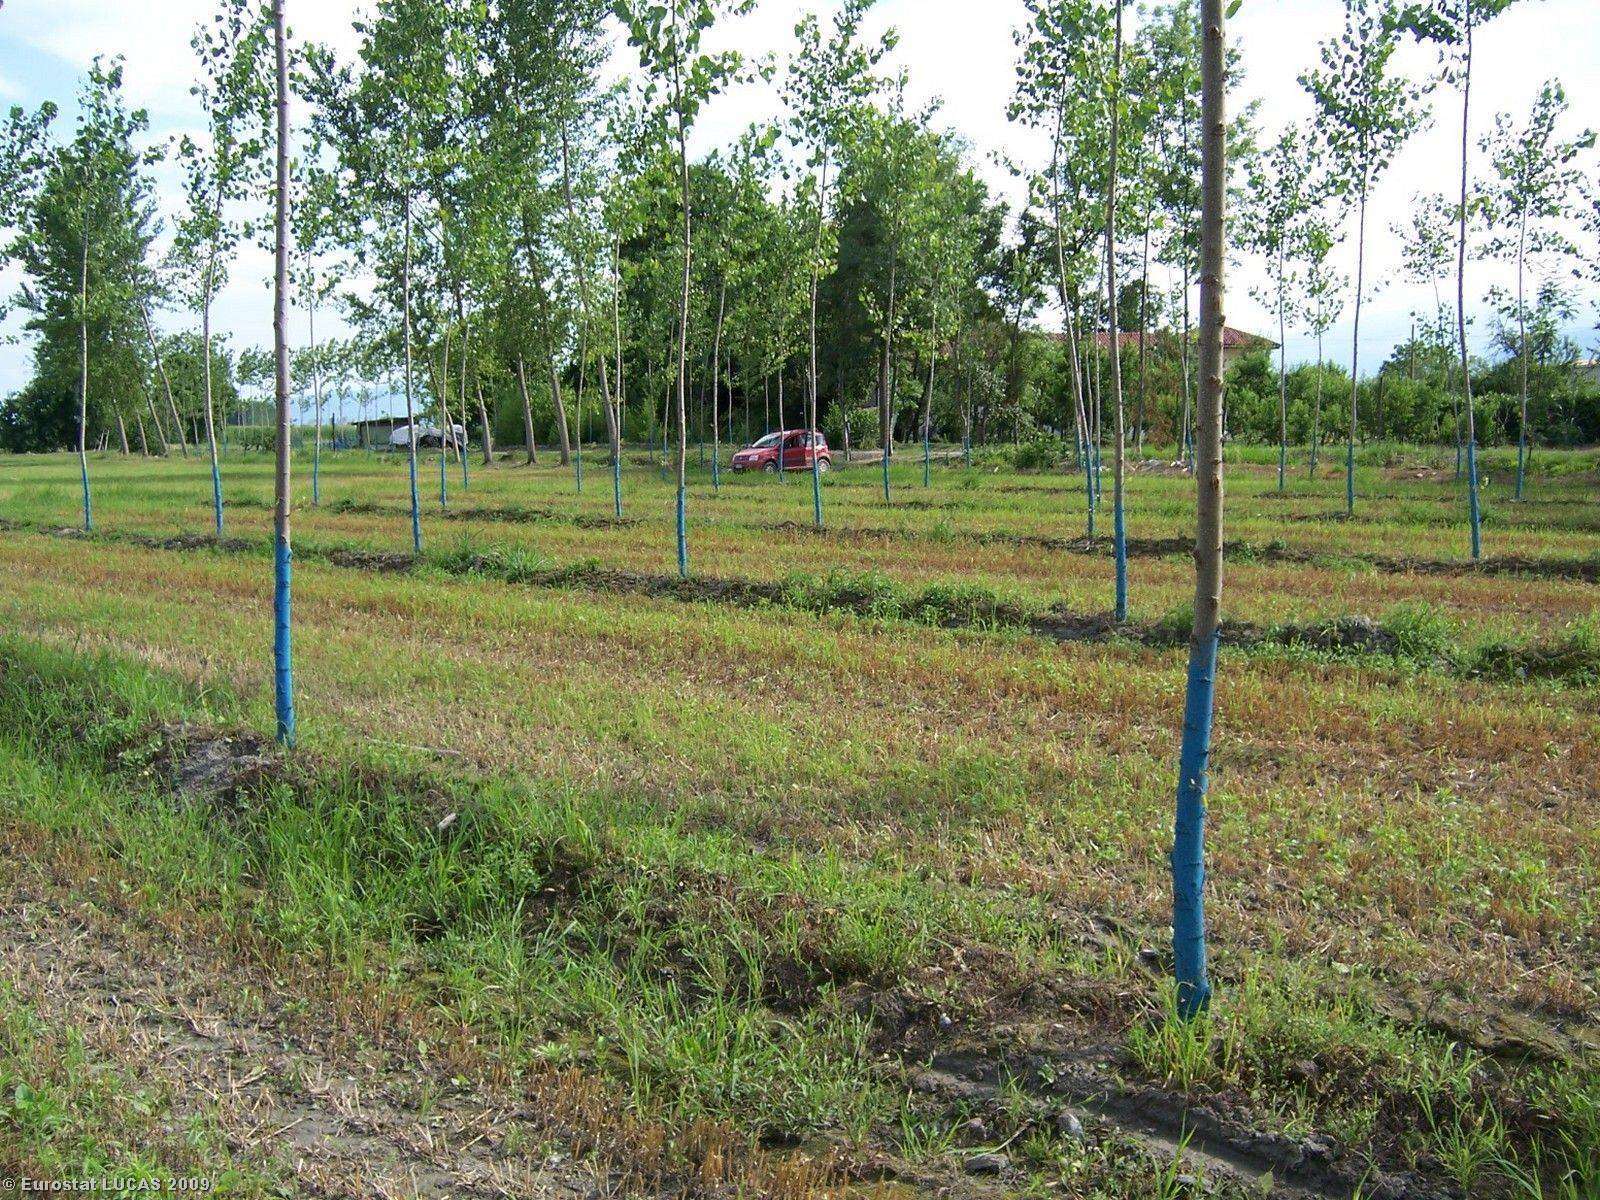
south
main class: Woodland
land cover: Broadleaved woodland
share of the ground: 25 - 50 %
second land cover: Barley
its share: > 75 %
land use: Forestry
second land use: Agriculture (excluding fallow land and kitchen gardens)
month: July
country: IT
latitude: 44.8409
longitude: 7.3860
